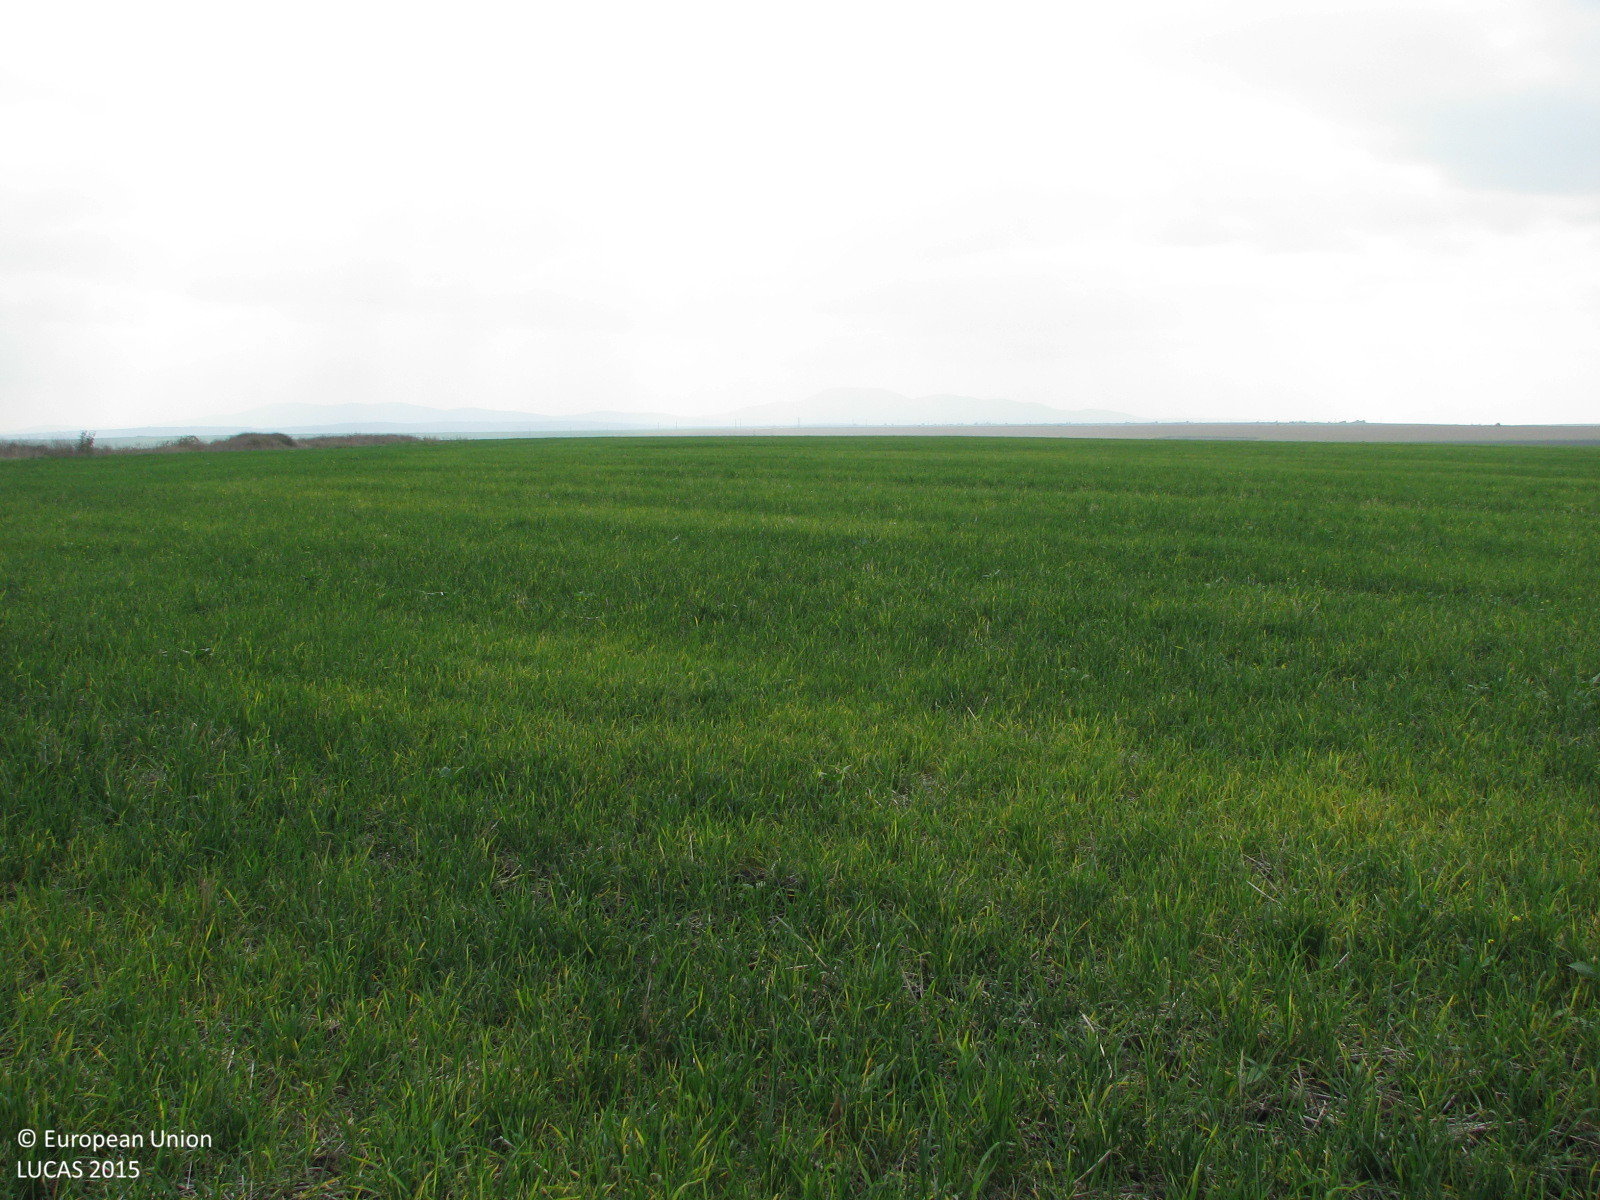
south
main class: Cropland
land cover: Common wheat
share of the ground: > 75 %
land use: Agriculture (excluding fallow land and kitchen gardens)
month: October
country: BG
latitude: 42.3403
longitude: 26.4880
